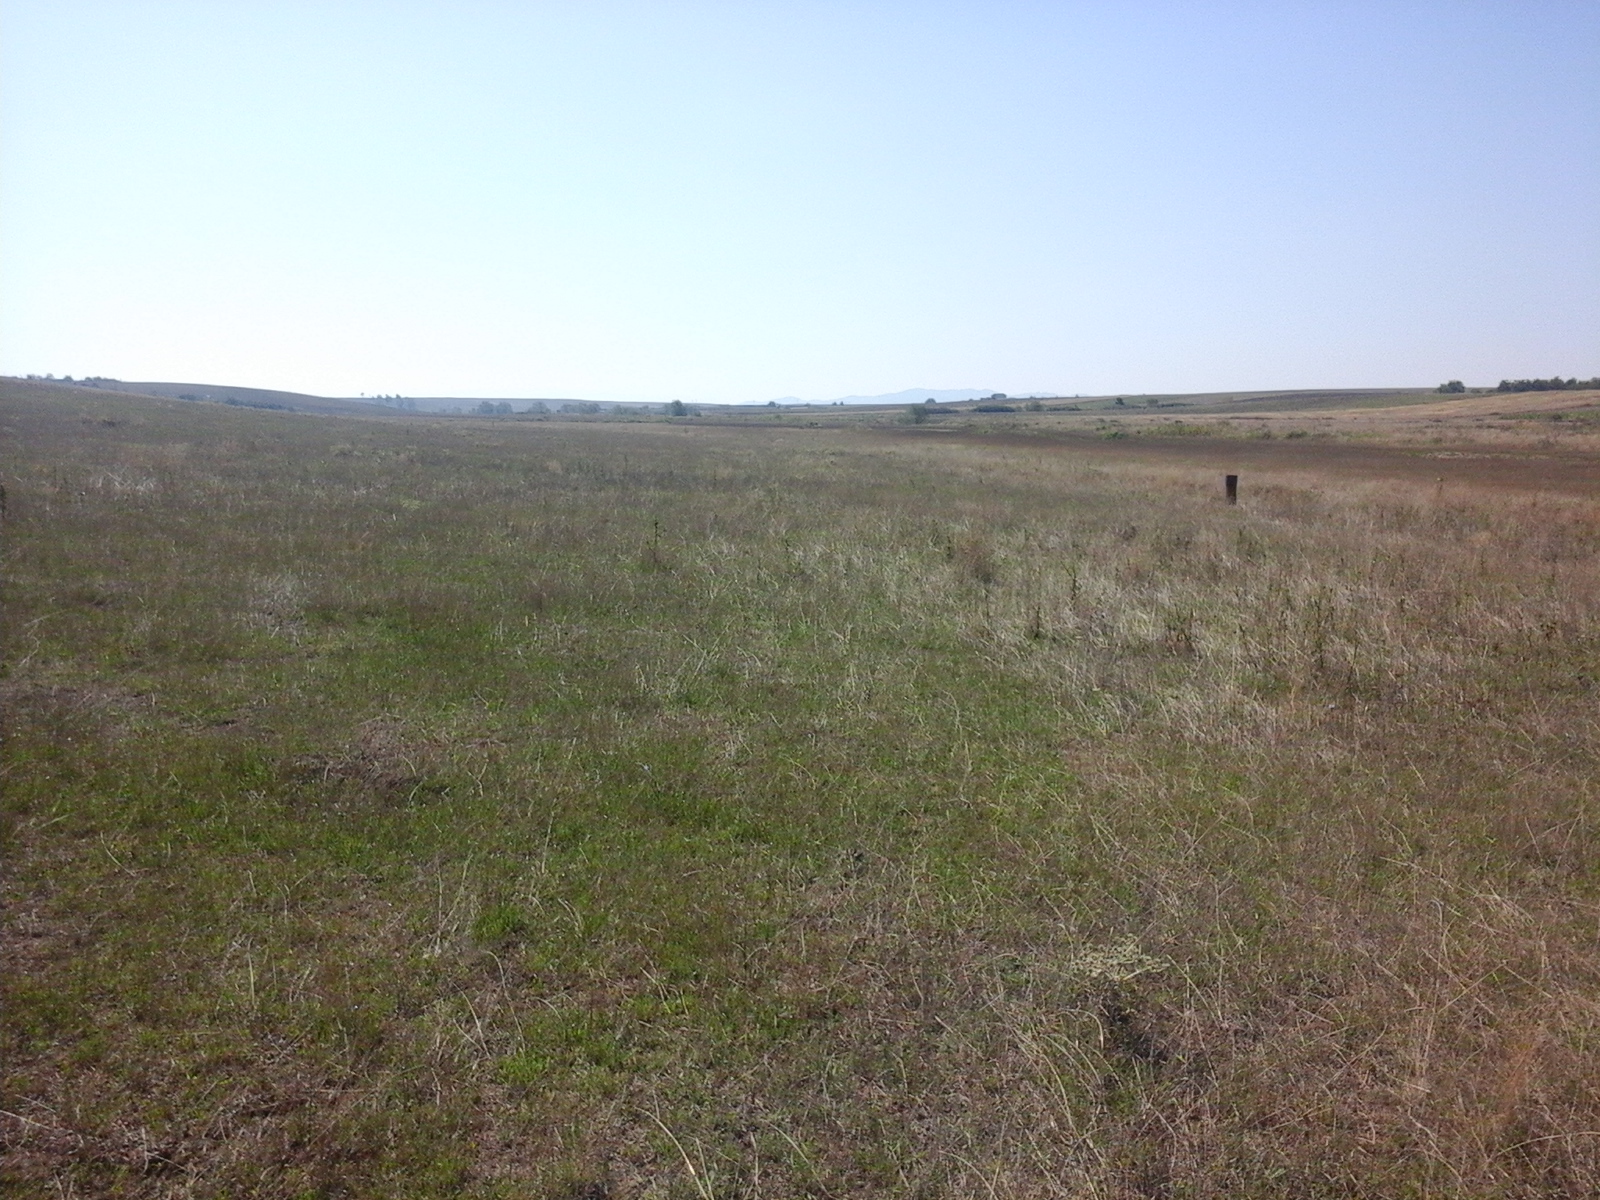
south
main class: Grassland
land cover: Grassland without tree/shrub cover
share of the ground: > 75 %
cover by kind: herbaceous plants 100 %
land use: Agriculture (excluding fallow land and kitchen gardens)
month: August
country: RO
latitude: 45.6464
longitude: 21.7509
